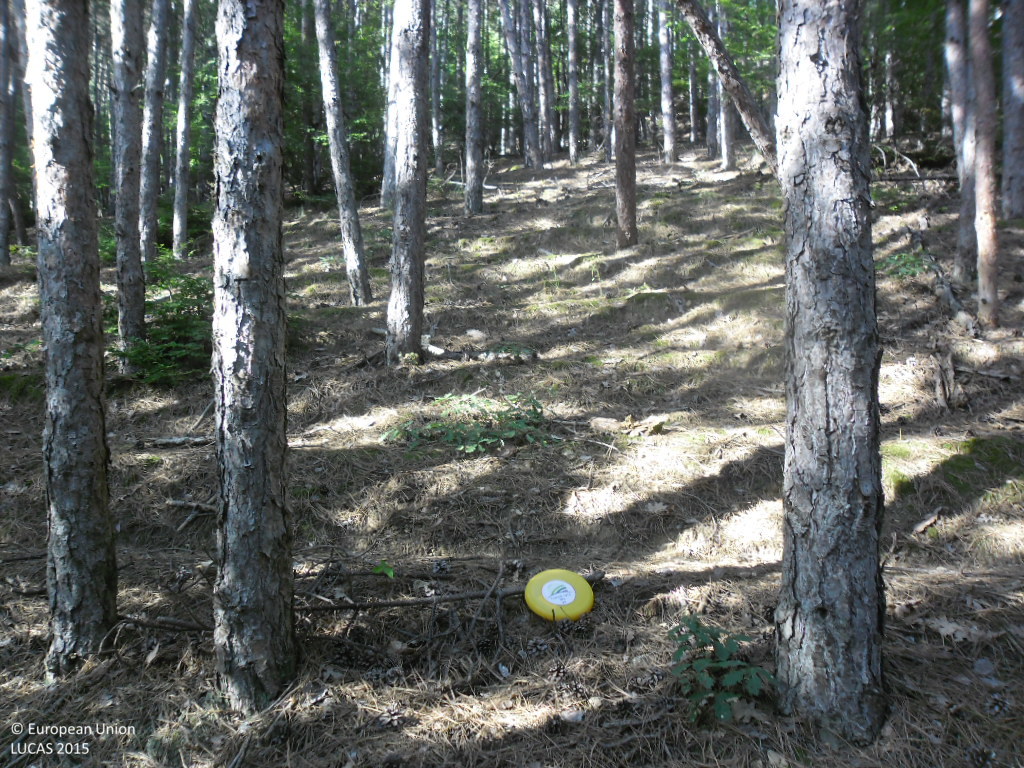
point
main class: Woodland
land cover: Pine dominated coniferous woodland
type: hemiboreal forest and nemoral coniferous forest and mixed broadleaved-coniferous forest
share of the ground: > 75 %
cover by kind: coniferous forest trees 85 %, broadleaved forest trees 10 %, unconsolidated bare surface 5 %
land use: Forestry
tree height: > 5 m
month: September
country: BG
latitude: 41.4547
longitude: 23.0785
